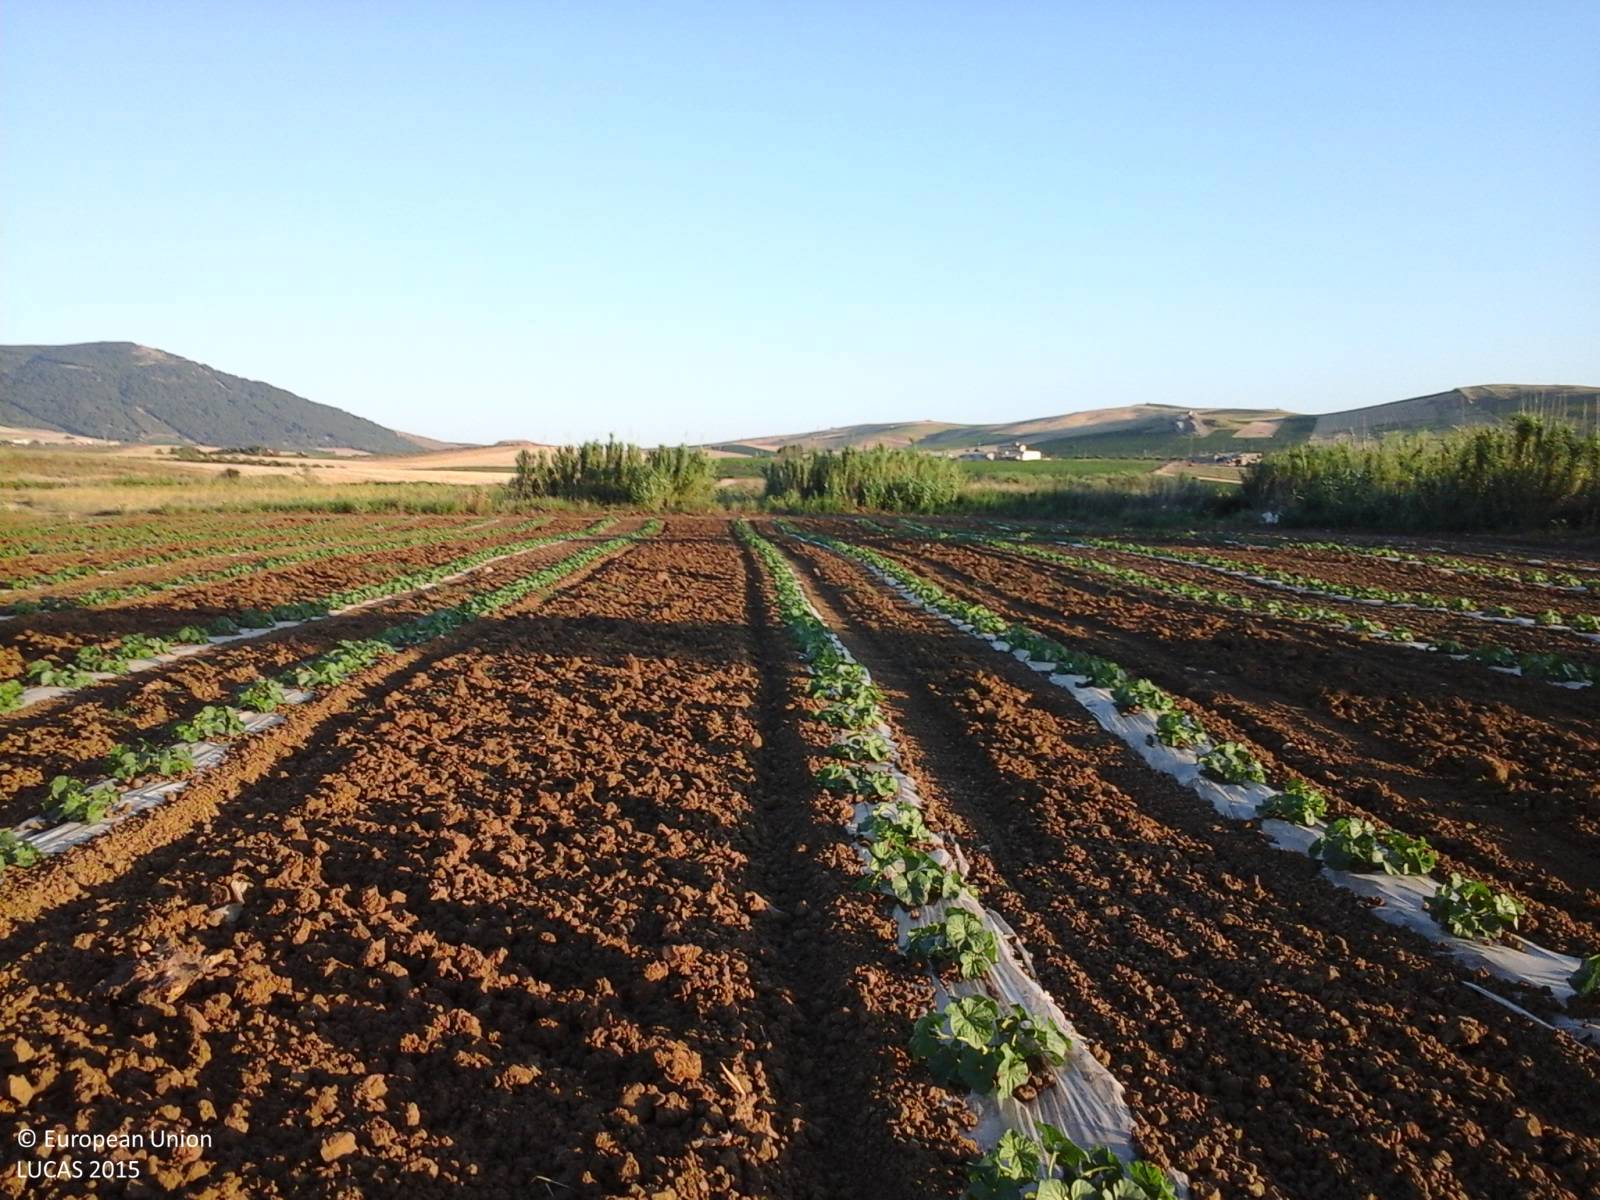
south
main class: Cropland
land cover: Other fresh vegetables
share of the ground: 10 - 25 %
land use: Agriculture (excluding fallow land and kitchen gardens)
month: June
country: IT
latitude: 37.9447
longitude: 12.7226
